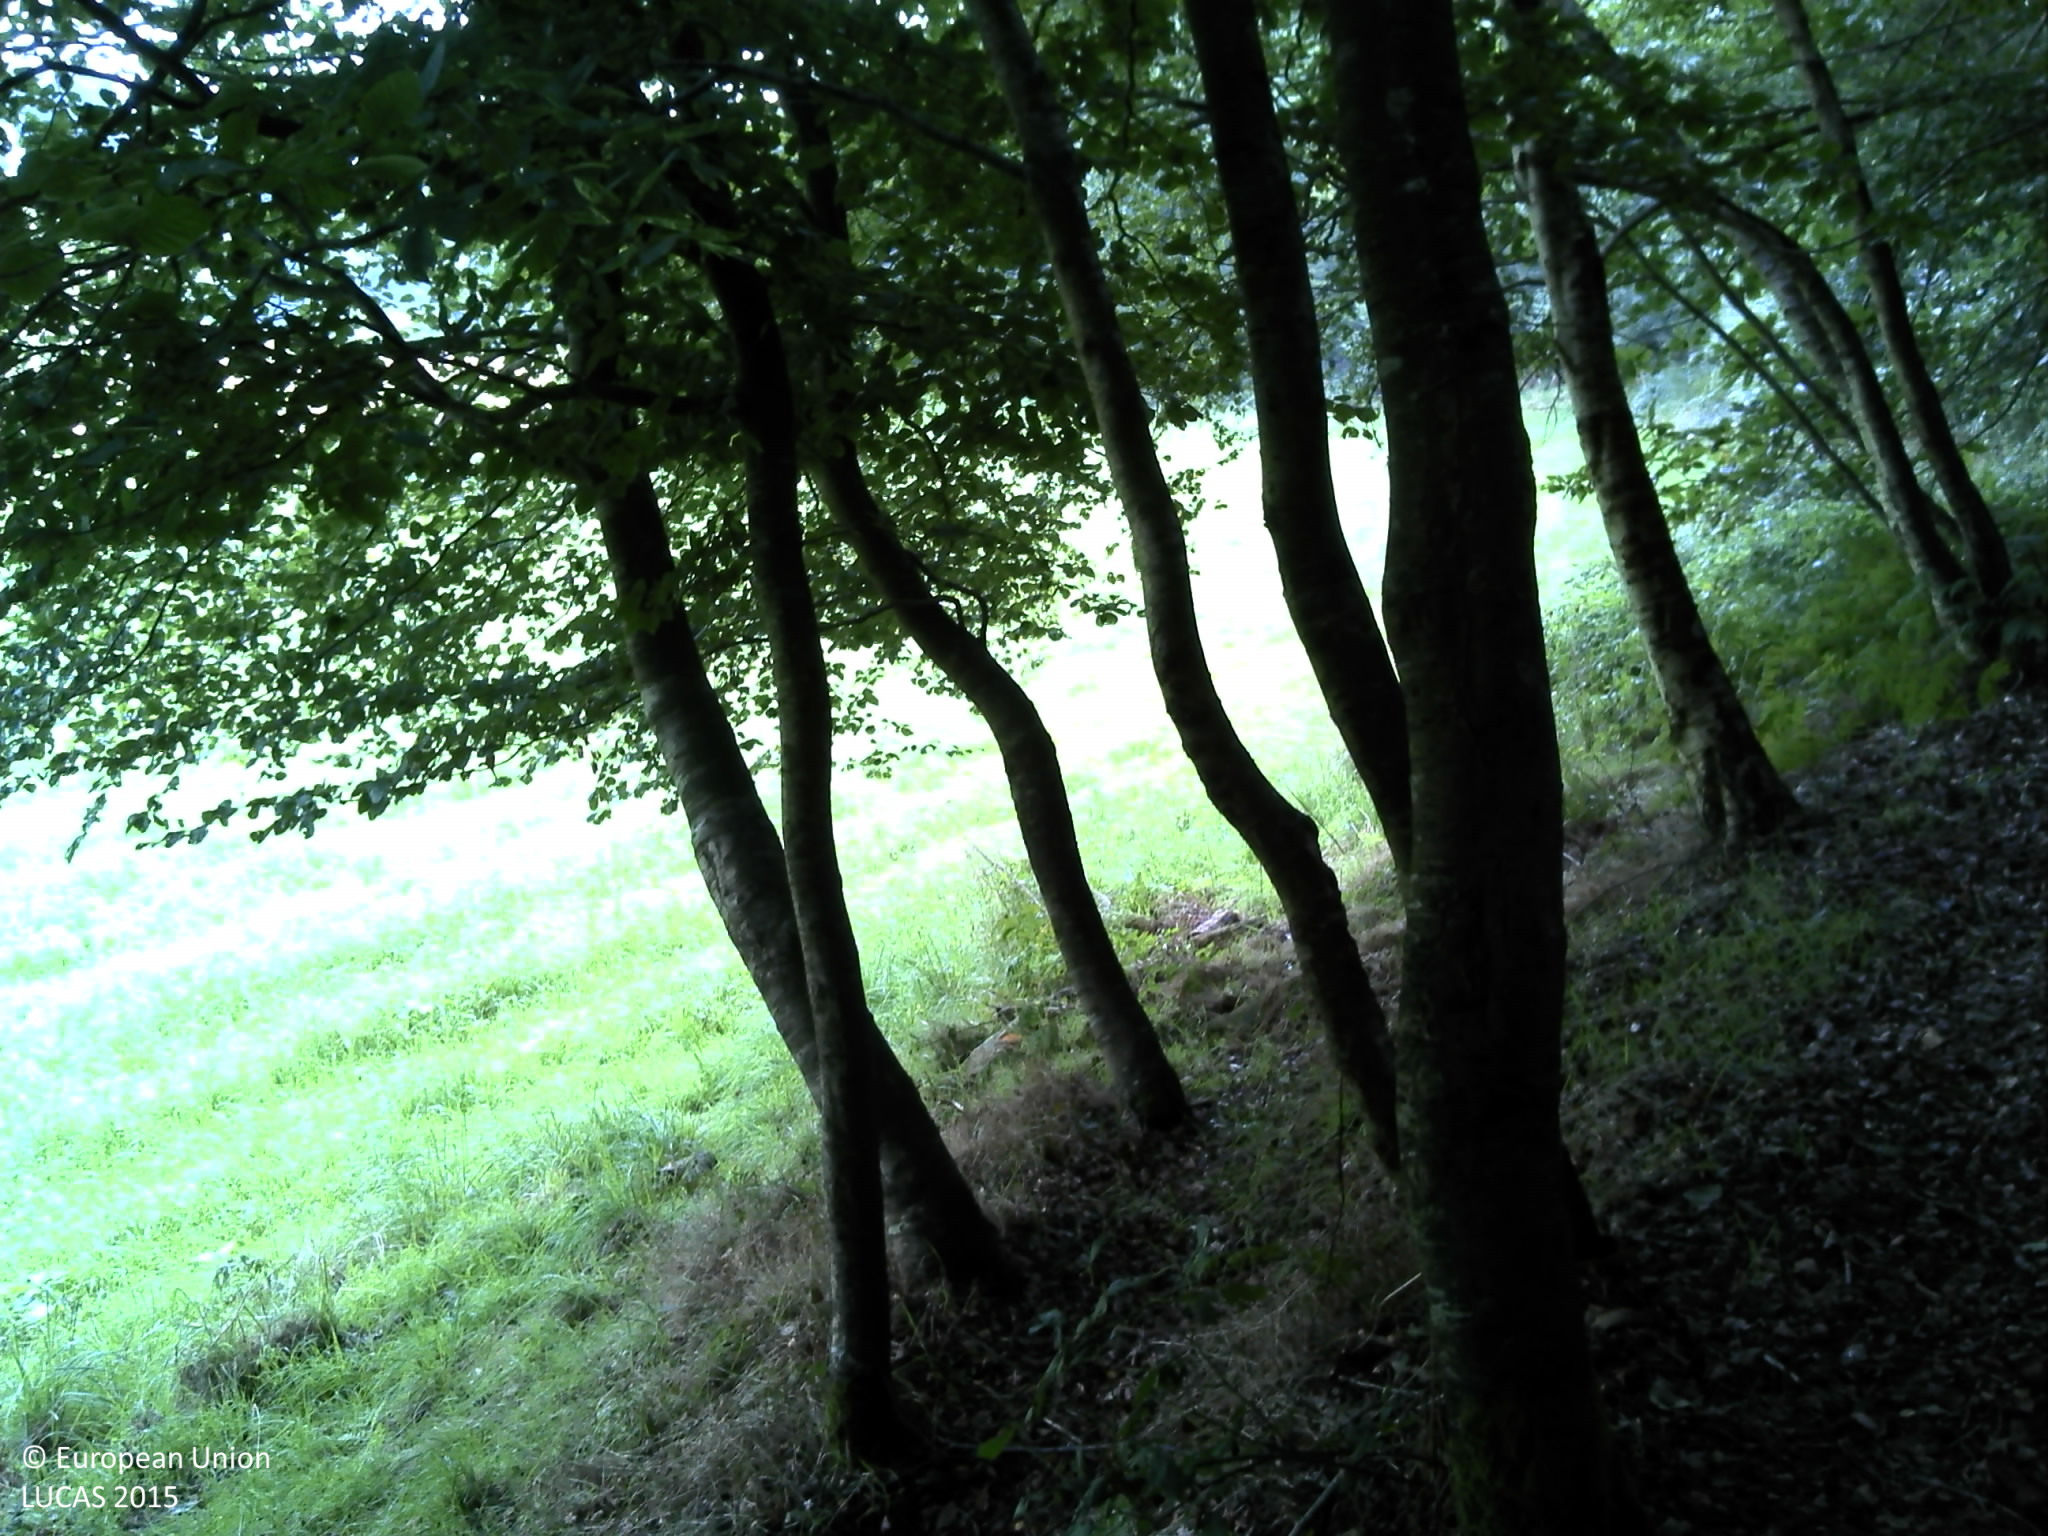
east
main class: Woodland
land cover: Broadleaved woodland
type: beech forest
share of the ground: > 75 %
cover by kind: broadleaved forest trees 100 %
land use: Forestry
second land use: Agriculture (excluding fallow land and kitchen gardens)
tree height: > 5 m
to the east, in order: Broadleaved woodland; Grassland without tree/shrub cover; Broadleaved woodland; Fences; Tracks; Grassland without tree/shrub cover
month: August
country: FR
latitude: 48.5698
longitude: -4.2564
